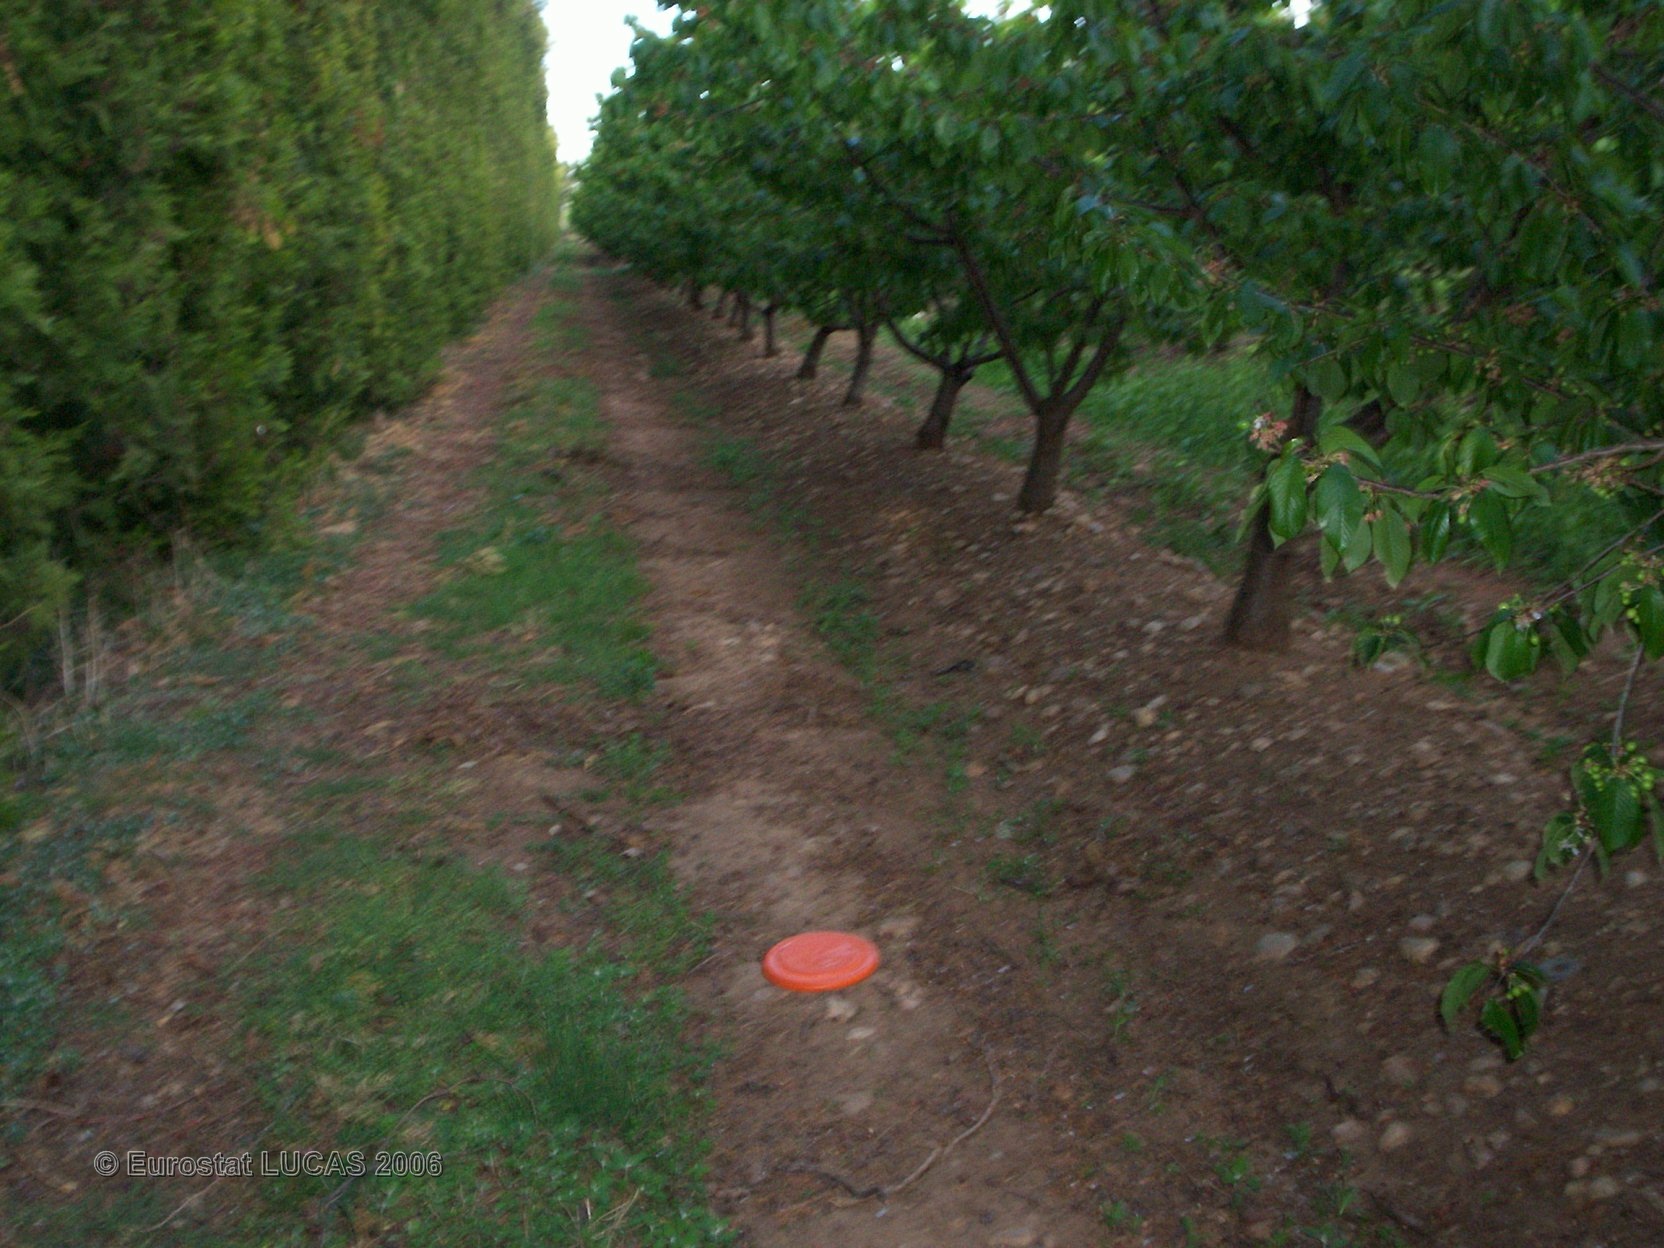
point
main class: Cropland
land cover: Cherry fruit
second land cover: Grassland with sparse tree/shrub cover
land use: Agriculture (excluding fallow land and kitchen gardens)
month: April
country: FR
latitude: 43.6500
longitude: 4.9634
